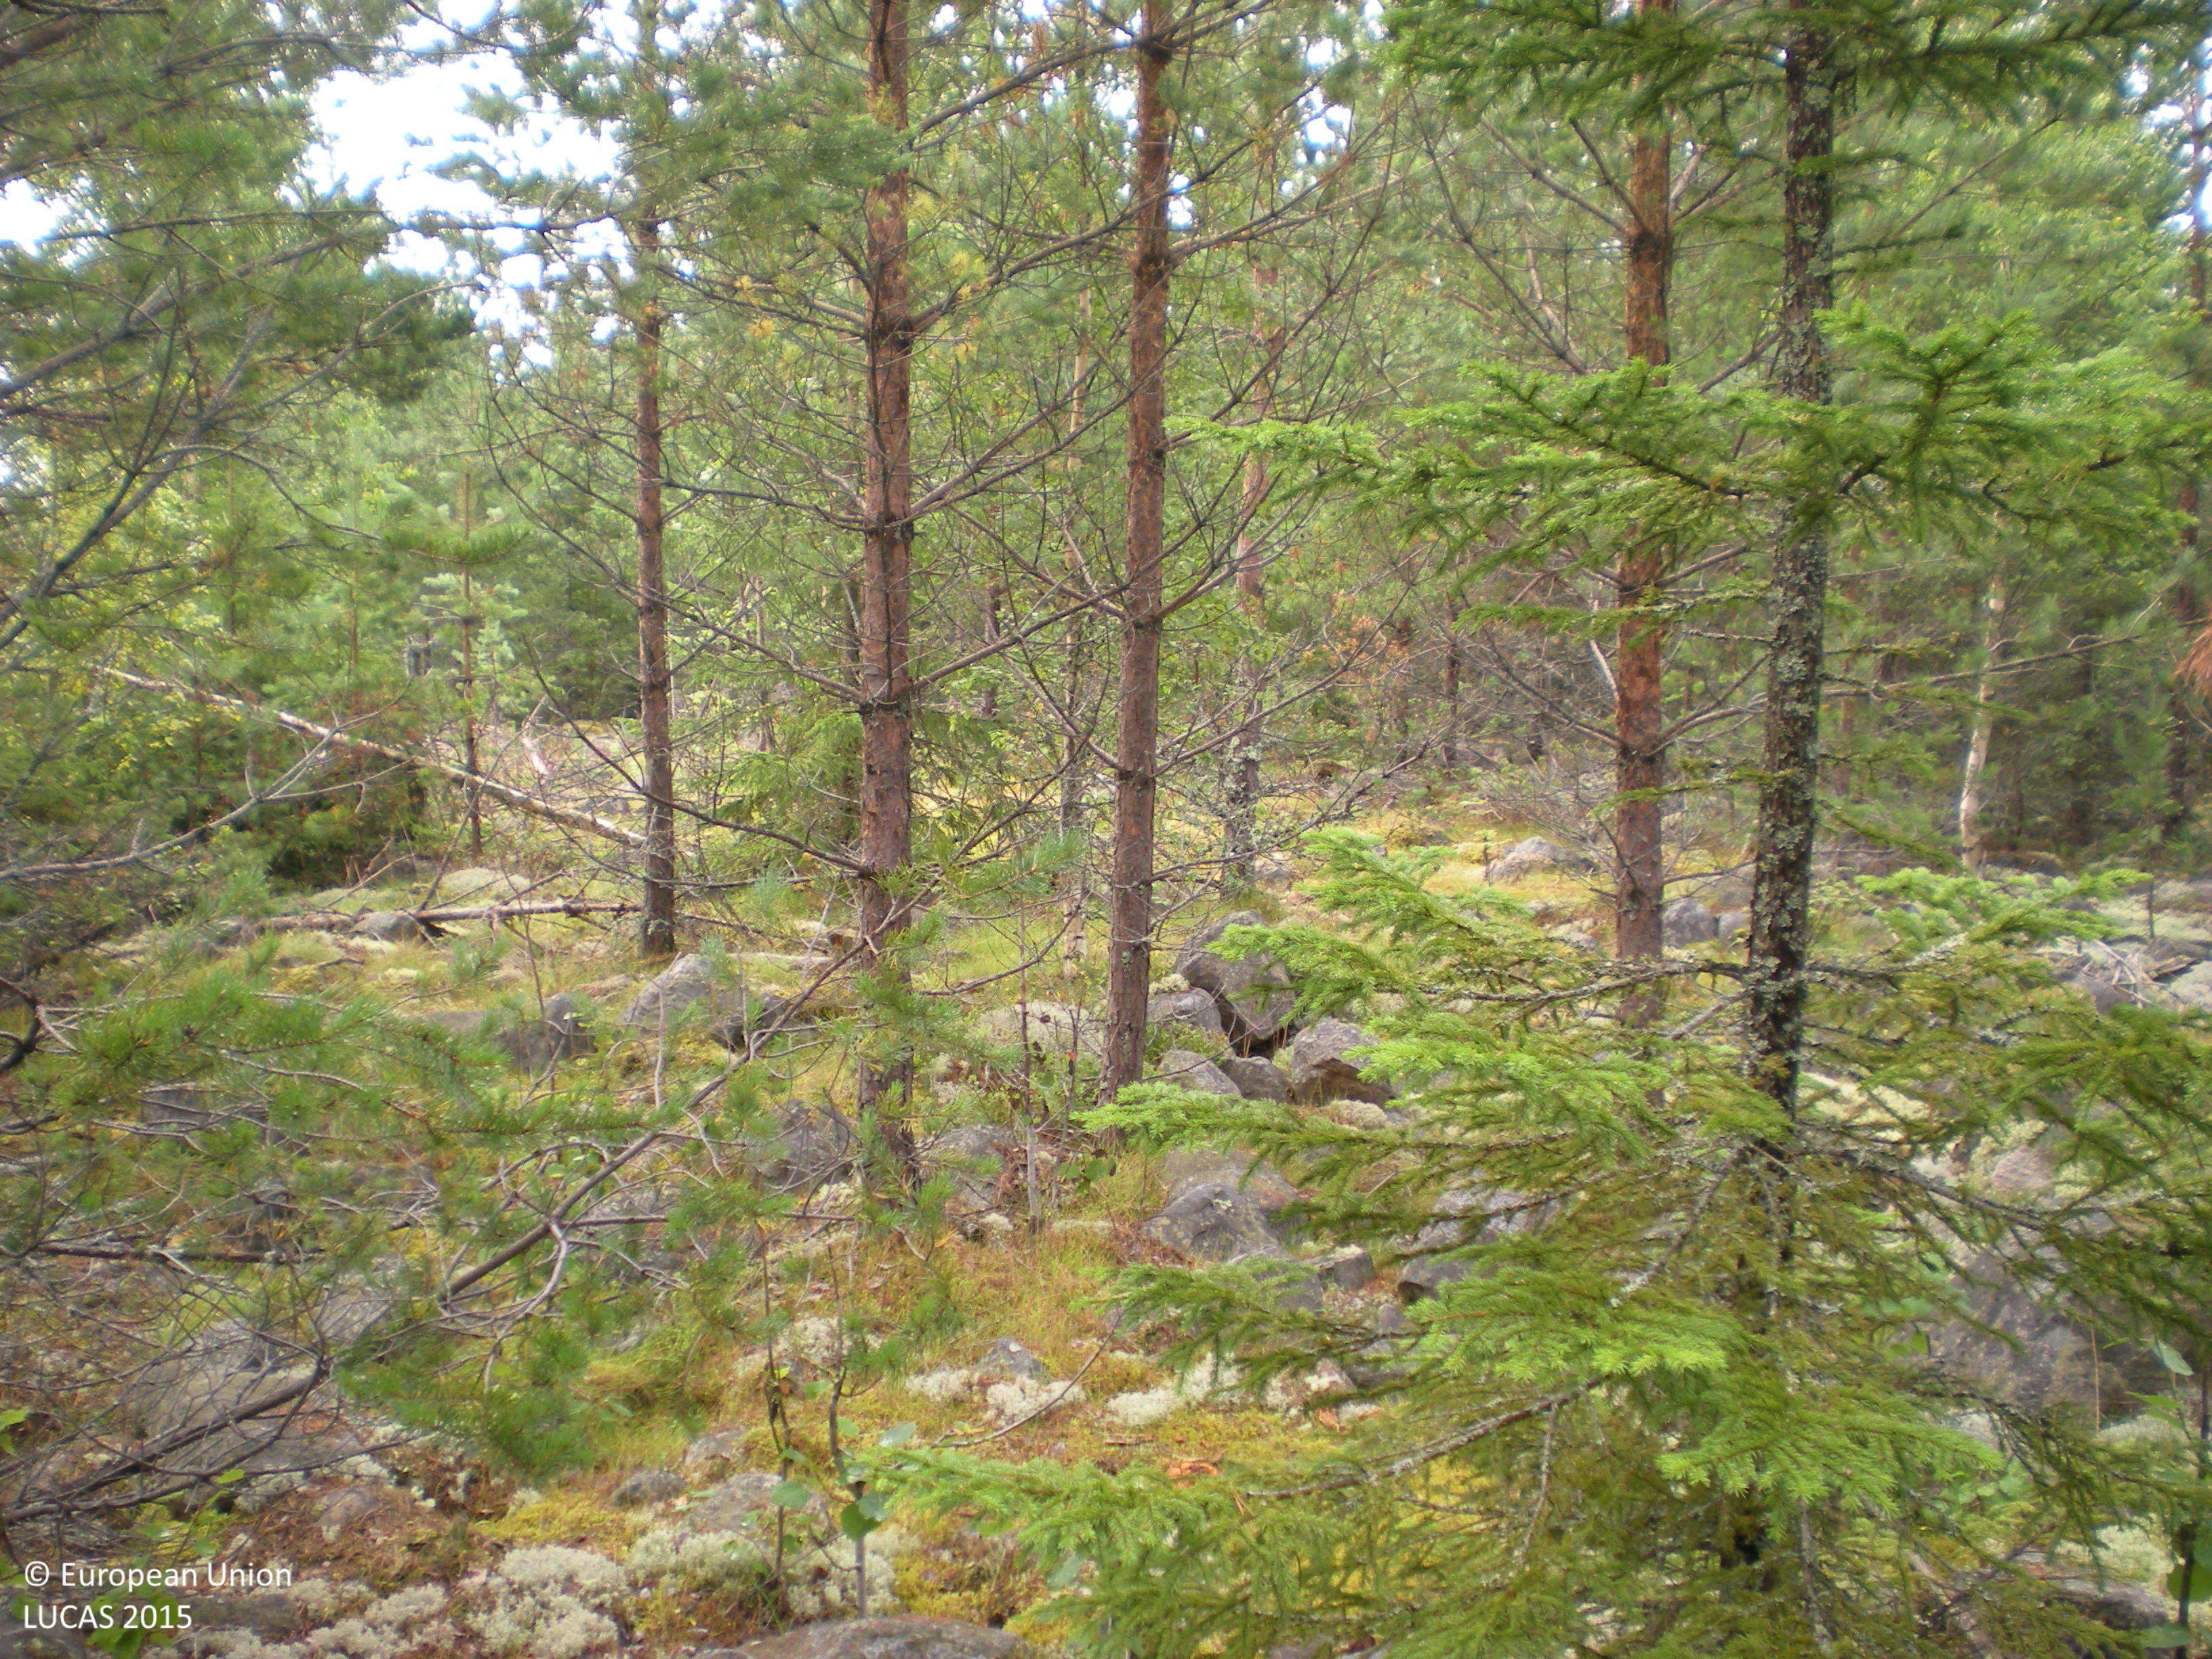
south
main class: Woodland
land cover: Pine dominated coniferous woodland
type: boreal forest
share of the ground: 50 - 75 %
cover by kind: coniferous forest trees 60 %, consolidated bare surface 15 %, lichens and mosses 10 %, broadleaved forest trees 5 %, shrubs 5 %, herbaceous plants 5 %
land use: Forestry
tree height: < 5 m
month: August
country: SE
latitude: 60.7708
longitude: 16.9093
